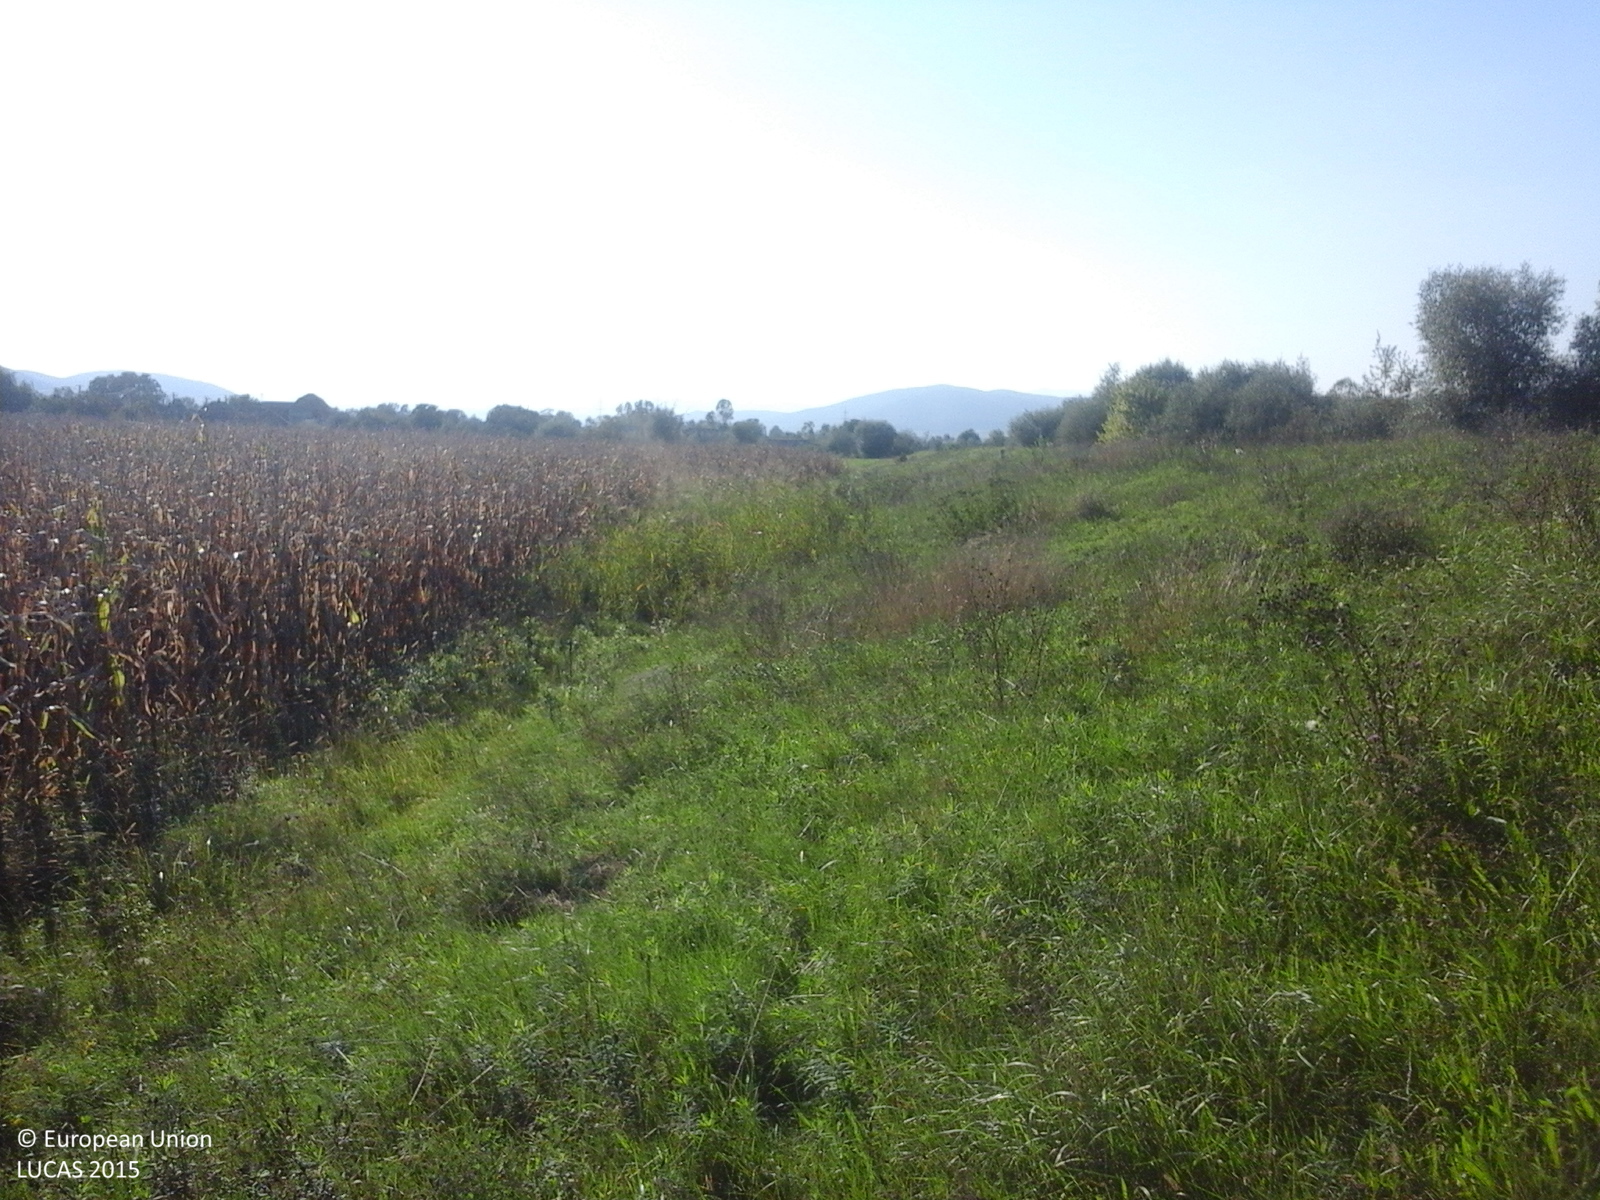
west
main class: Grassland
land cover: Grassland without tree/shrub cover
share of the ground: > 75 %
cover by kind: herbaceous plants 100 %
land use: Agriculture (excluding fallow land and kitchen gardens)
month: October
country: RO
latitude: 46.3808
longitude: 23.8156
